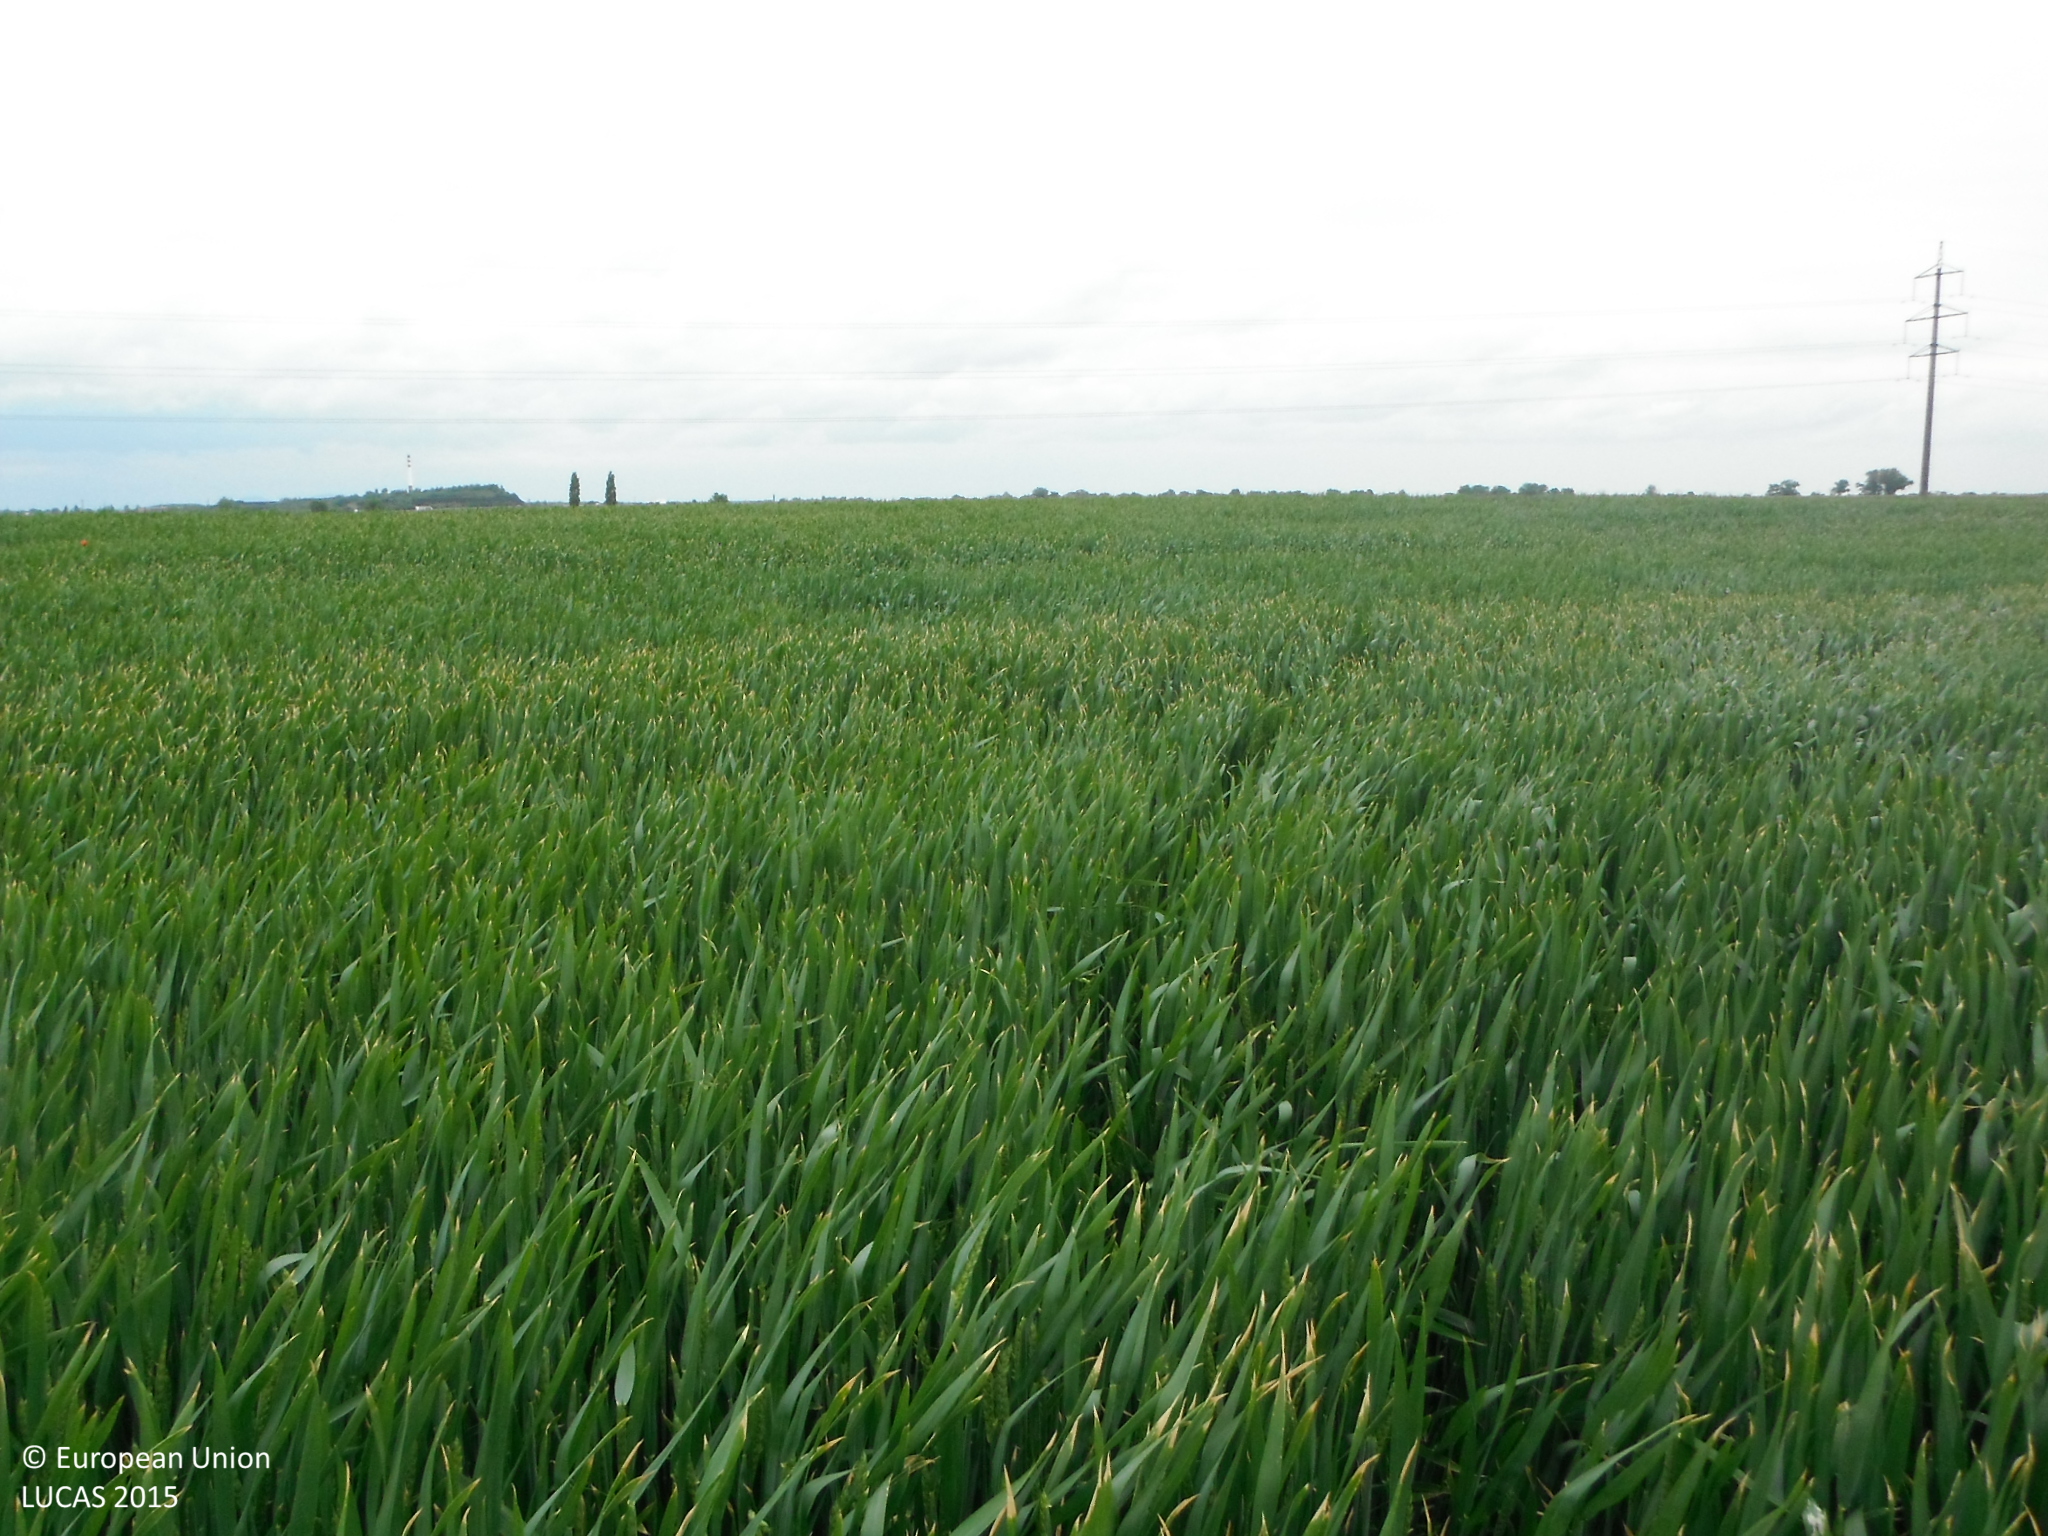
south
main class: Cropland
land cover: Common wheat
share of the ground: > 75 %
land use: Agriculture (excluding fallow land and kitchen gardens)
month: May
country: SK
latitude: 48.2611
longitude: 17.7029
